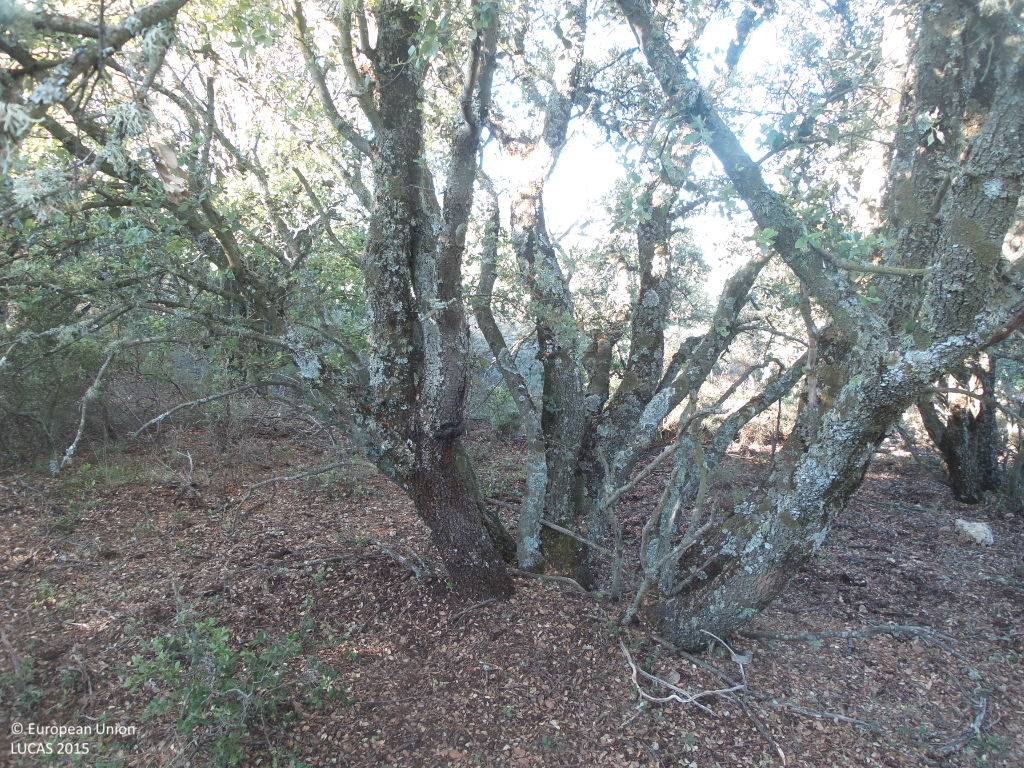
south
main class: Woodland
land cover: Broadleaved woodland
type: broadleaved evergreen forest
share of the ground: > 75 %
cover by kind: broadleaved forest trees 80 %, shrubs 10 %, herbaceous plants 5 %, unconsolidated bare surface 5 %
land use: Semi-natural and natural areas not in use
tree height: > 5 m
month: June
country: ES
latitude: 41.0373
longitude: -2.9177
